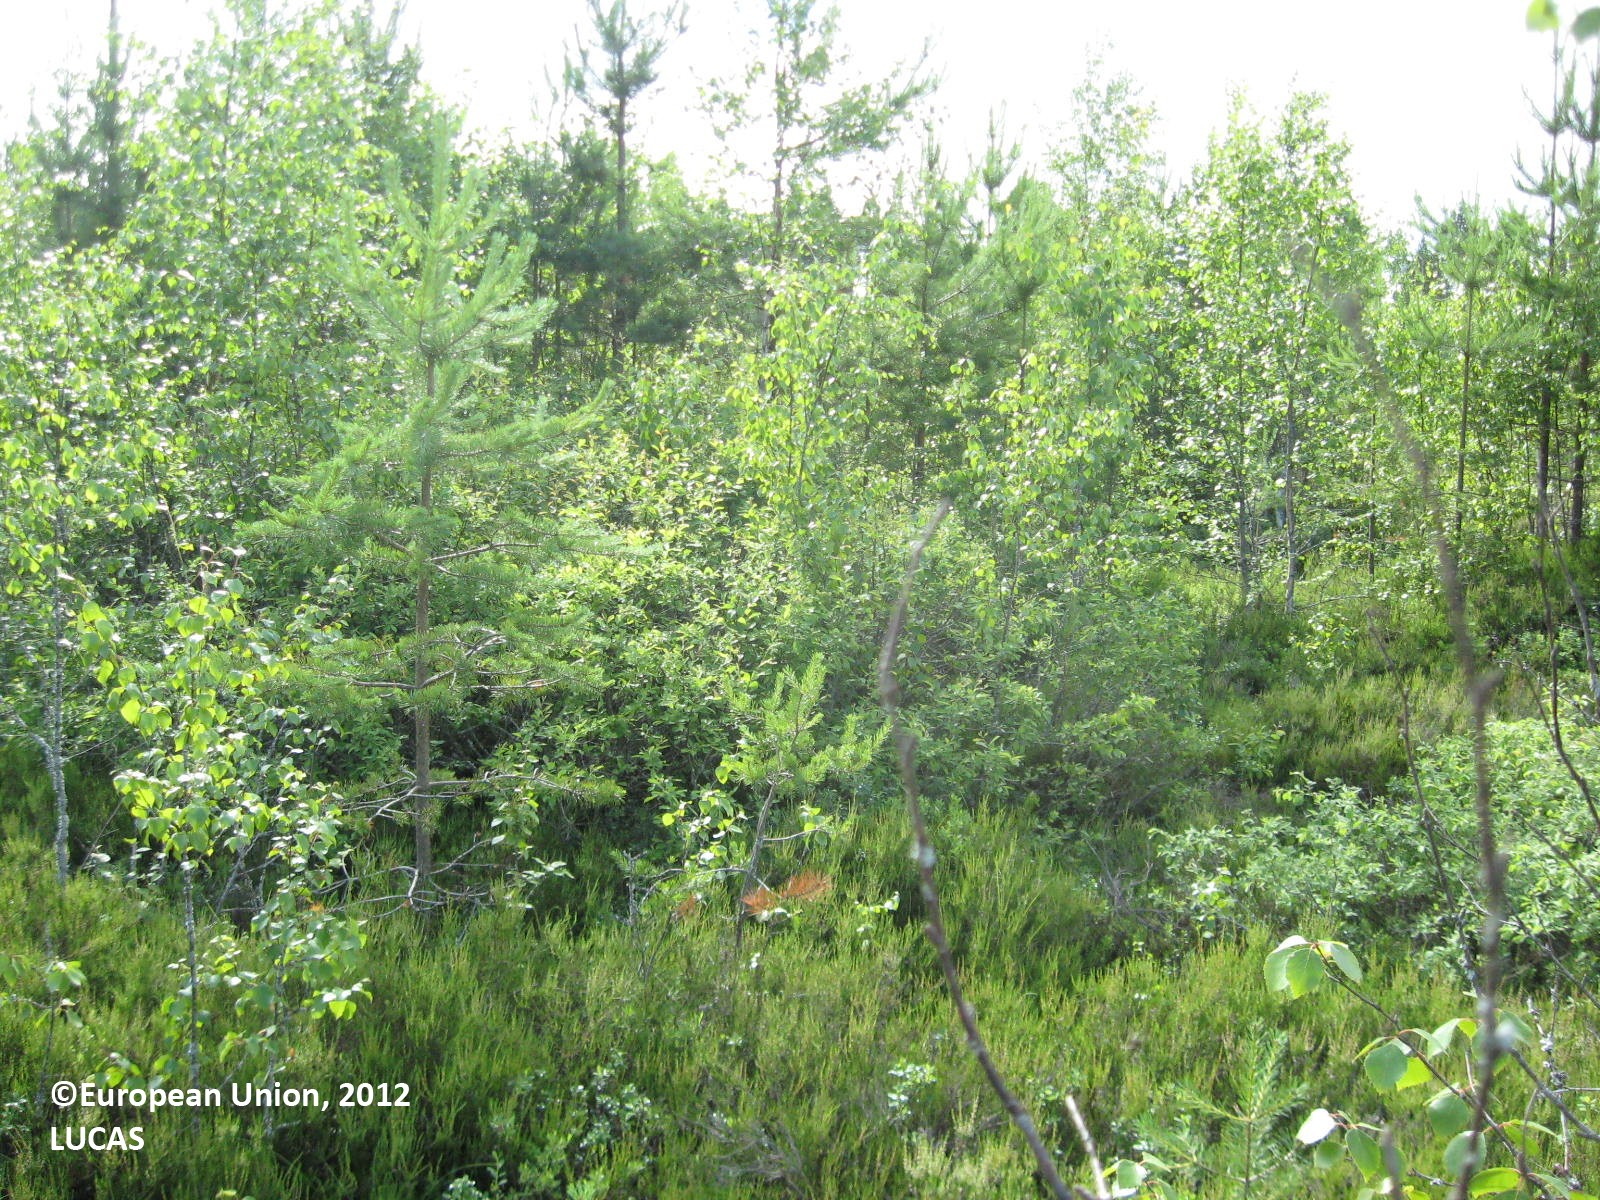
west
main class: Woodland
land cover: Other mixed woodland
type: boreal forest
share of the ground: 25 - 50 %
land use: Forestry
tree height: < 5 m
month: July
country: FI
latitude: 62.2750
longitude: 22.6804
